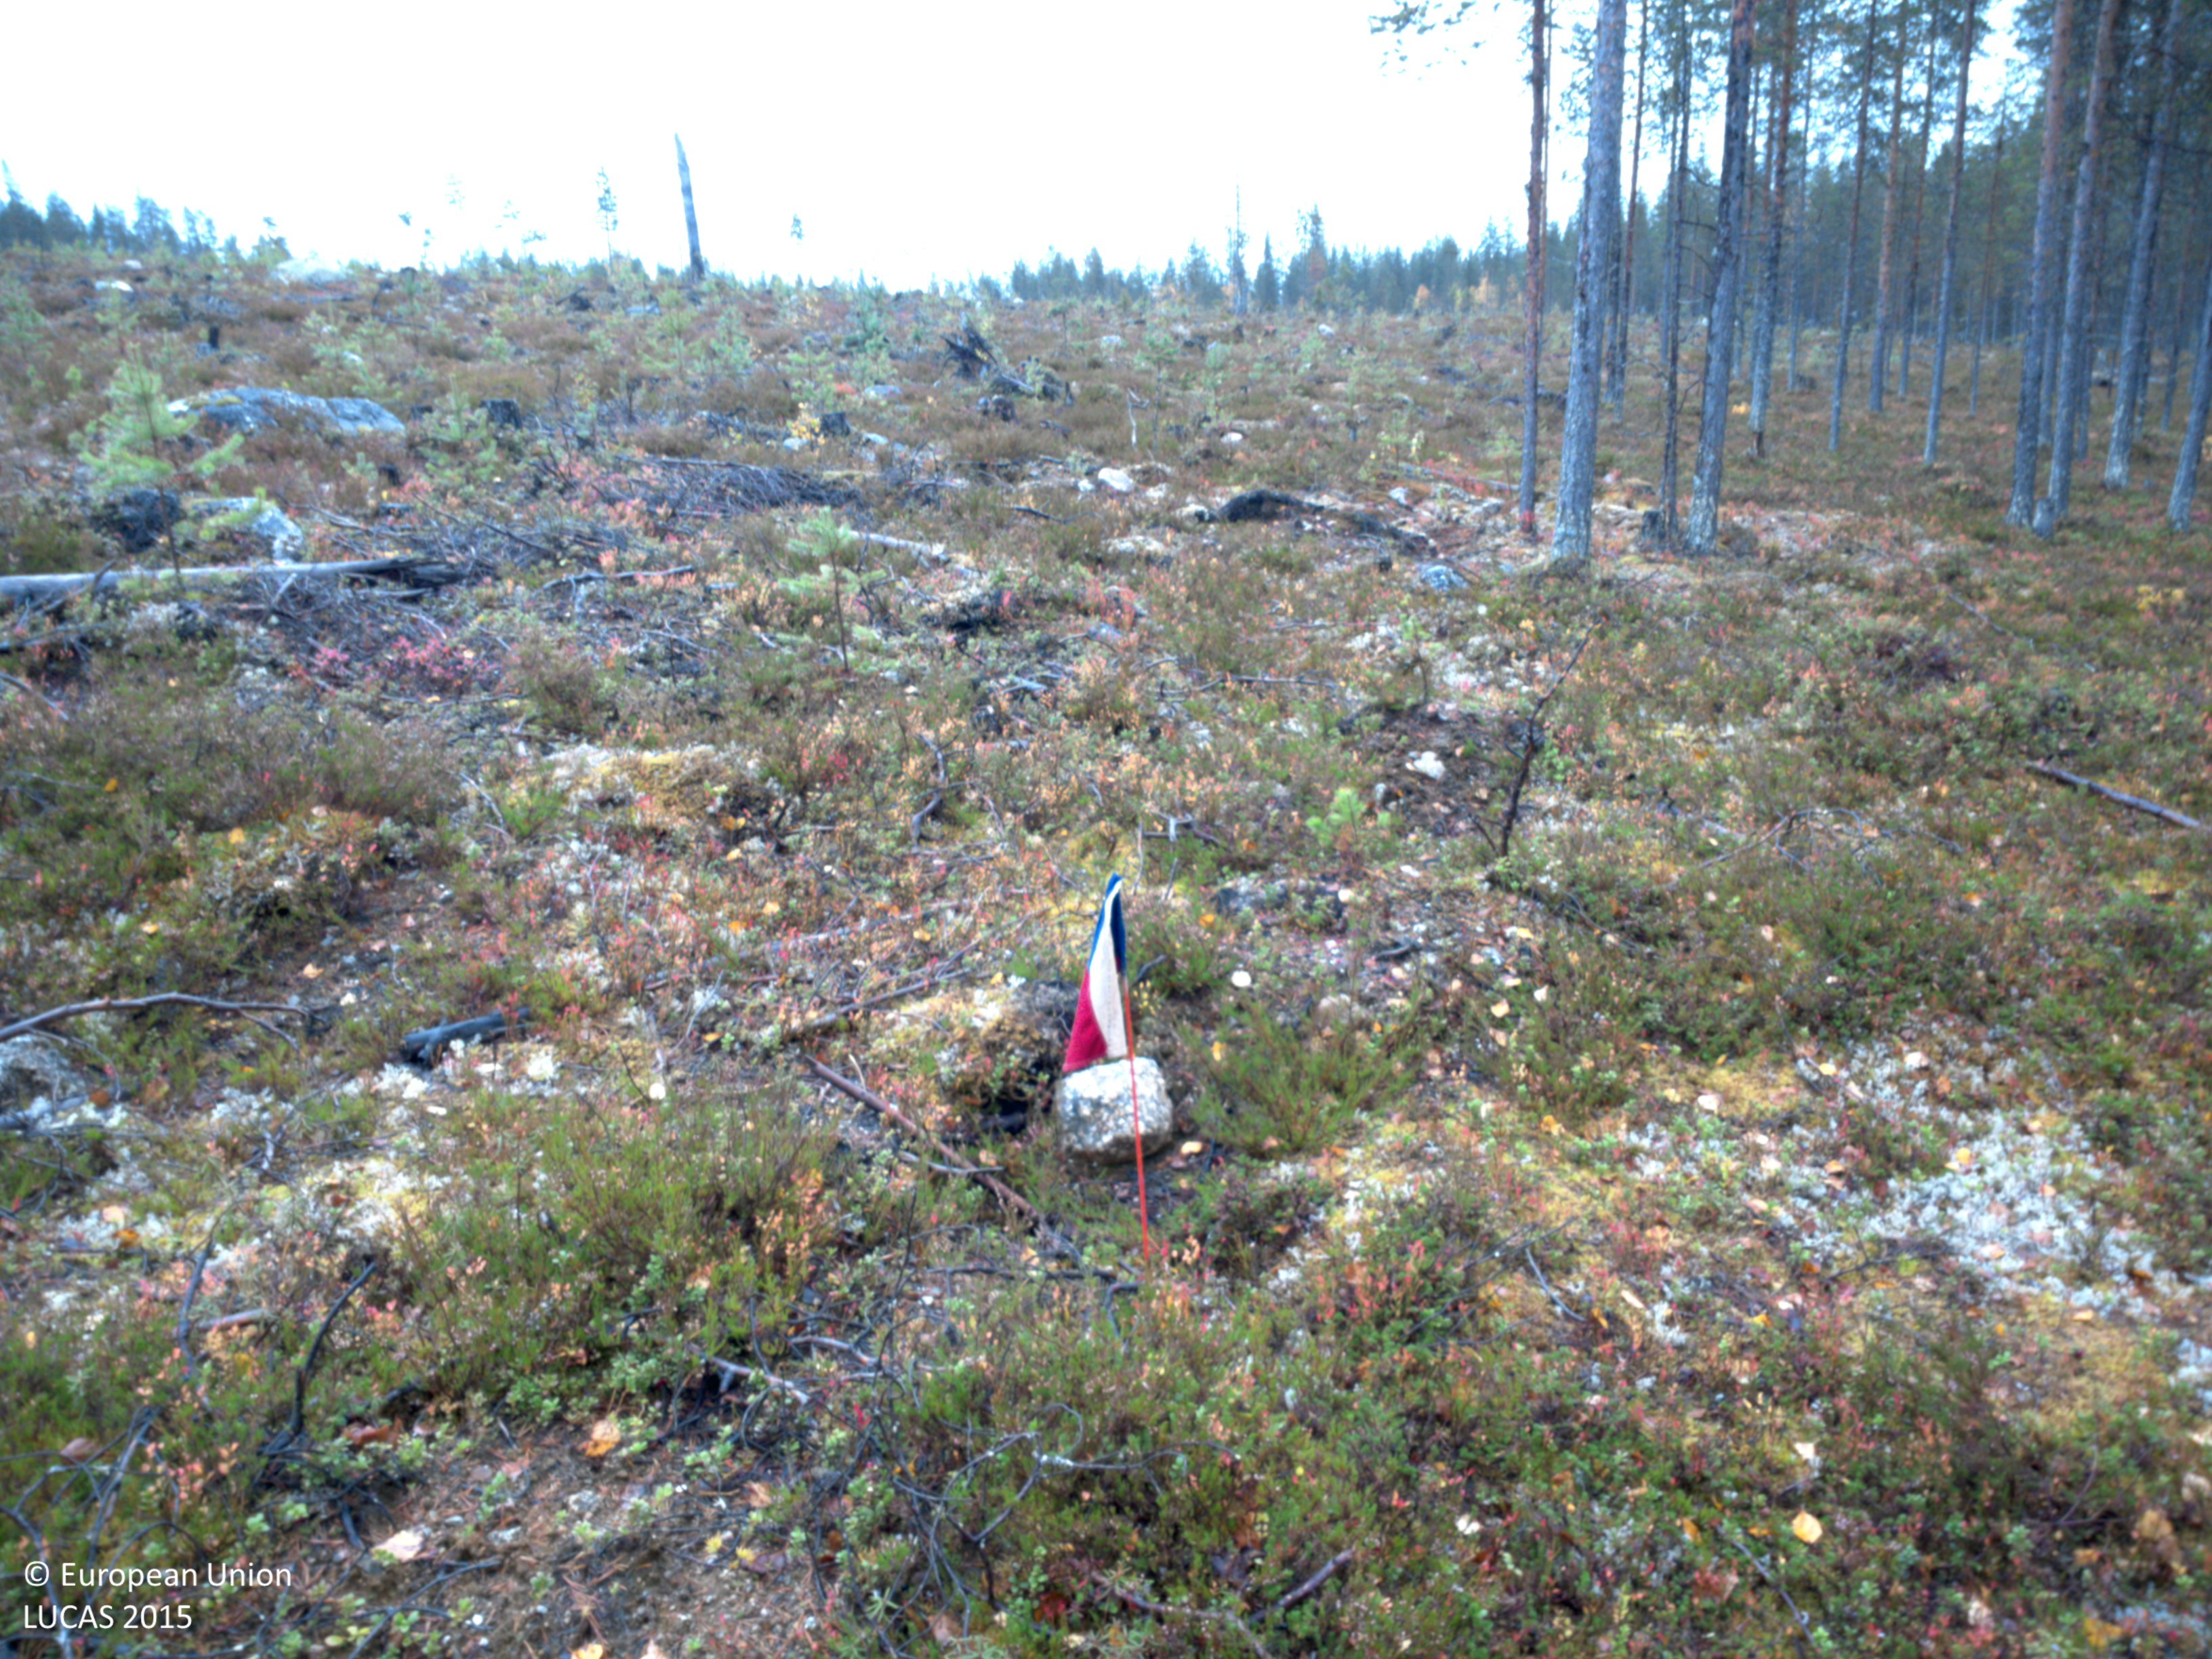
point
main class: Shrubland
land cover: Shrubland with sparse tree cover
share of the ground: > 75 %
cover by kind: shrubs 75 %, herbaceous plants 10 %, lichens and mosses 10 %, coniferous forest trees 5 %
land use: Forestry
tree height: < 5 m
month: September
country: SE
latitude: 64.8092
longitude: 18.7892
